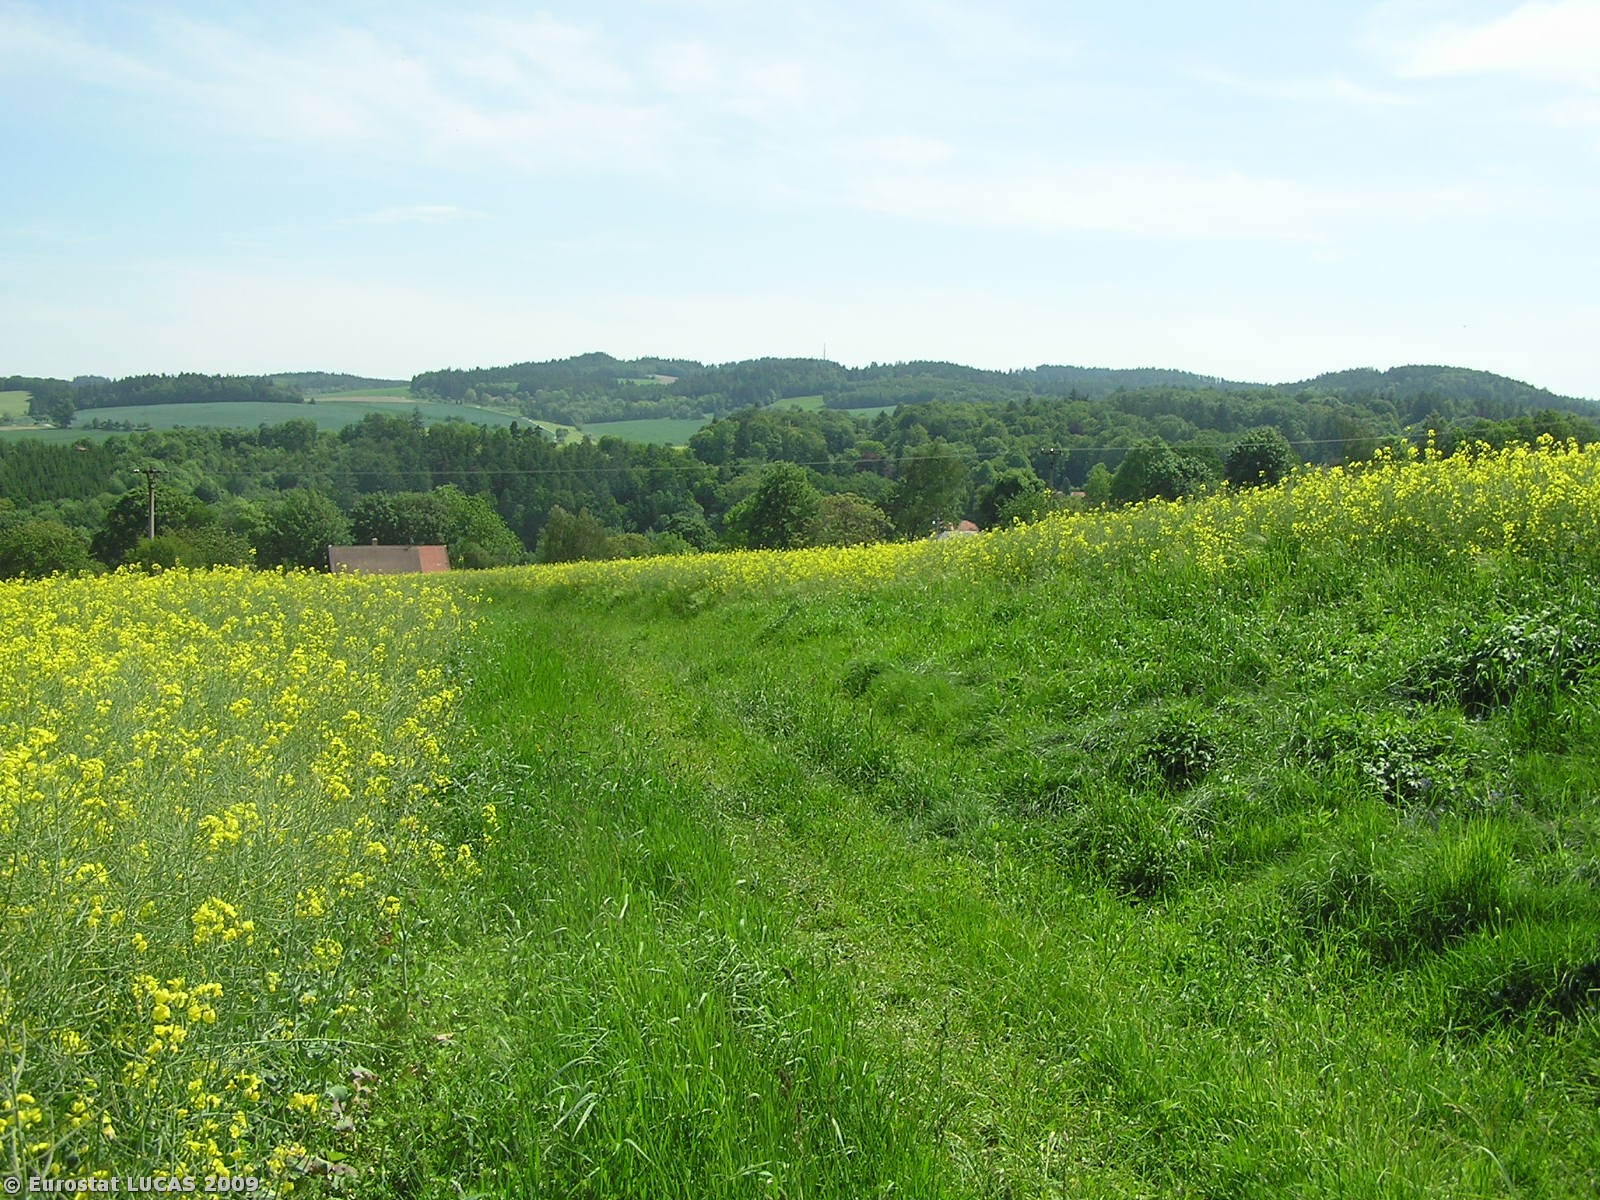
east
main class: Cropland
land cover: Rape and turnip rape
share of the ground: > 75 %
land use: Agriculture (excluding fallow land and kitchen gardens)
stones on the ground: 10 - 25 %
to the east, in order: Rape and turnip rape; Electric lines; Rape and turnip rape; Grass margins; Tracks; Rape and turnip rape; Grass margins; Tracks; Grassland without tree/shrub cover; Fences; Artificial constructions in urban areas
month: May
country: CZ
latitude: 49.6047
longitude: 14.6096
